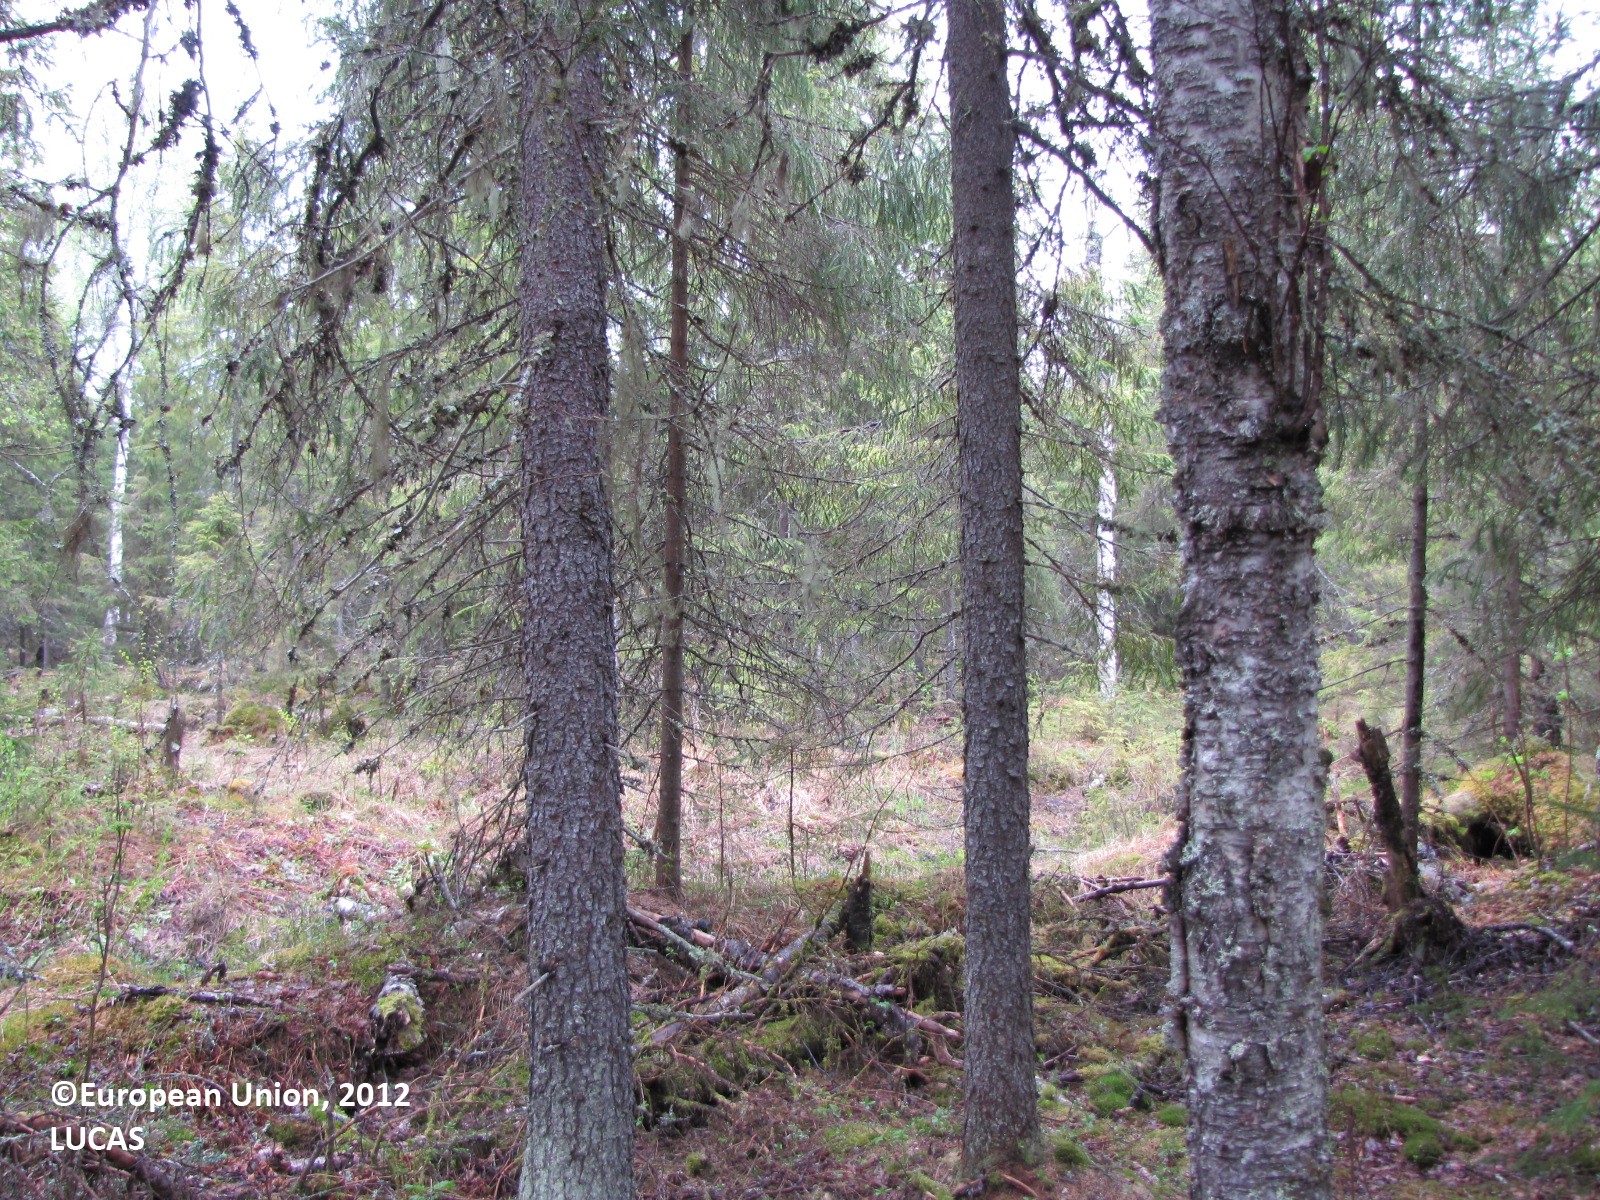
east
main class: Woodland
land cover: Spruce dominated coniferous woodland
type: boreal forest
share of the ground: 50 - 75 %
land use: Forestry
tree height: > 5 m
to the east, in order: Spruce dominated coniferous woodland; Spruce dominated mixed woodland; Ditches and canals; Spruce dominated mixed woodland; Ditches and canals; Spruce dominated mixed woodland; Ditches and canals; Spruce dominated mixed woodland; Ditches and canals; Spruce dominated mixed woodland; Ditches and canals; Grassland without tree/shrub cover; Ditches and canals; Grassland without tree/shrub cover; Ditches and canals; Grassland without tree/shrub cover
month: June
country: FI
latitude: 65.9556
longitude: 24.5473
